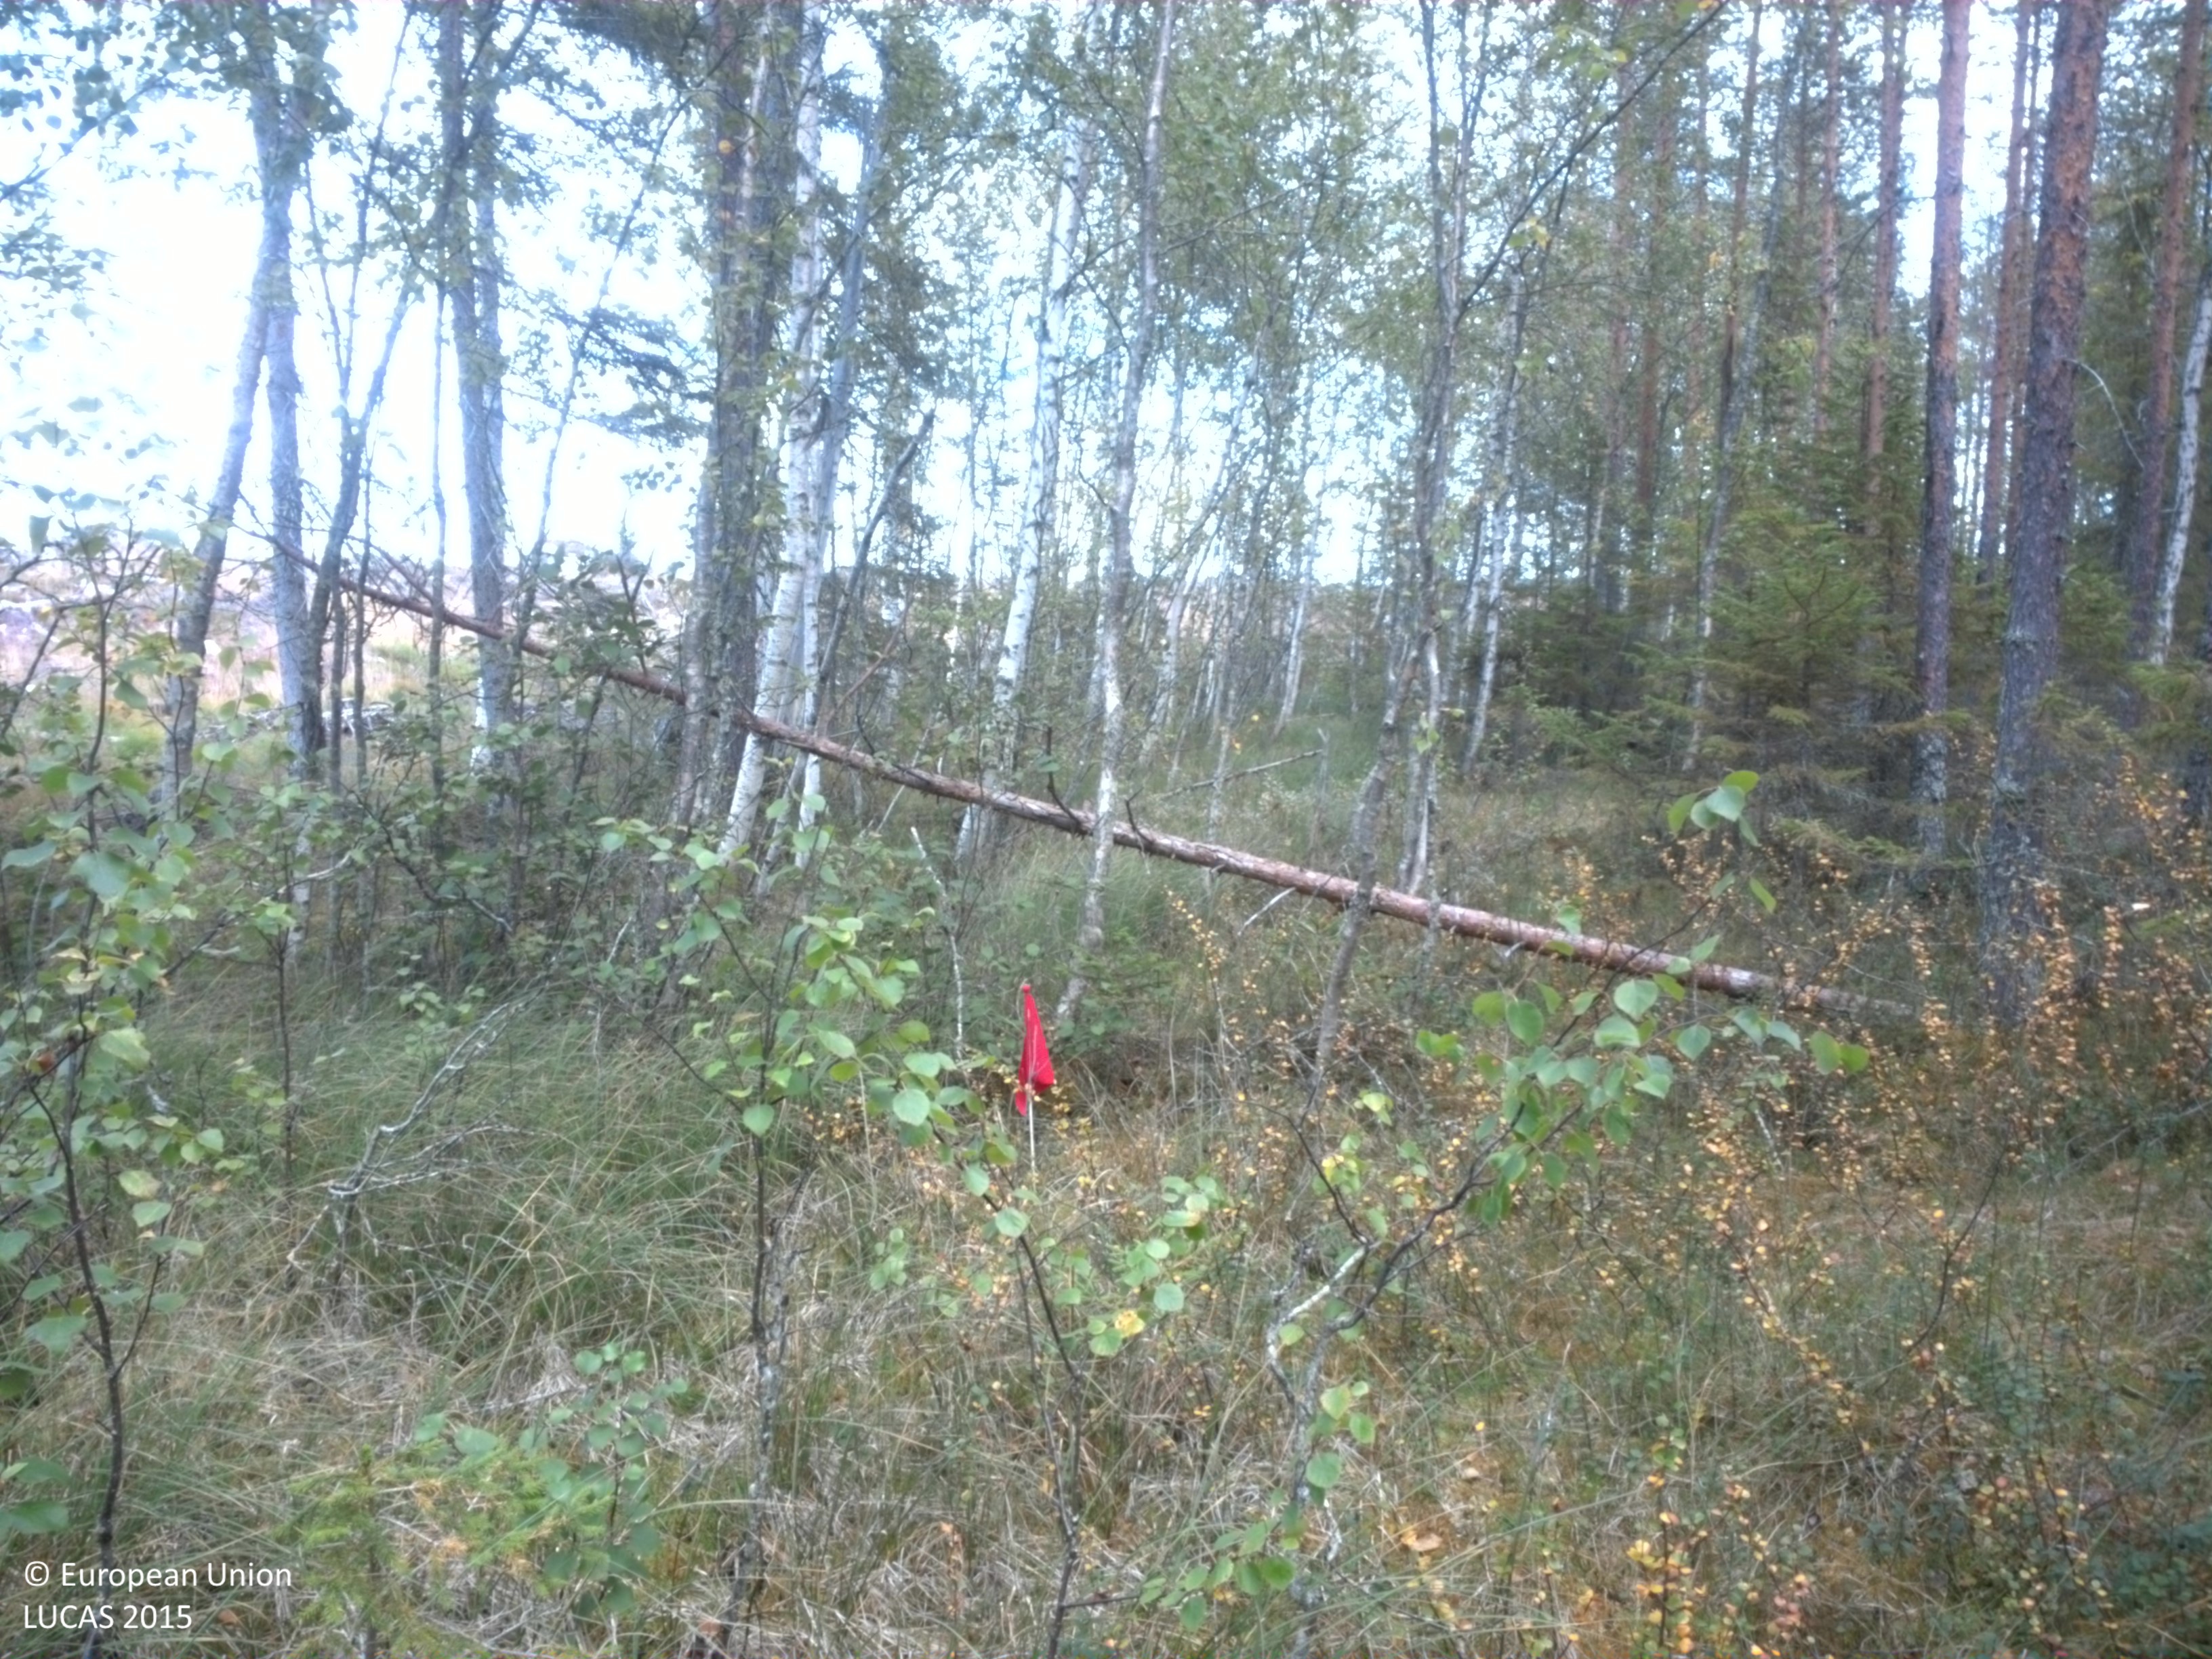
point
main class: Woodland
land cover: Other mixed woodland
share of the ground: 50 - 75 %
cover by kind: coniferous forest trees 25 %, broadleaved forest trees 25 %, herbaceous plants 20 %, lichens and mosses 20 %, shrubs 10 %
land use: Forestry
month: September
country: SE
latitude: 64.5682
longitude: 19.8024
